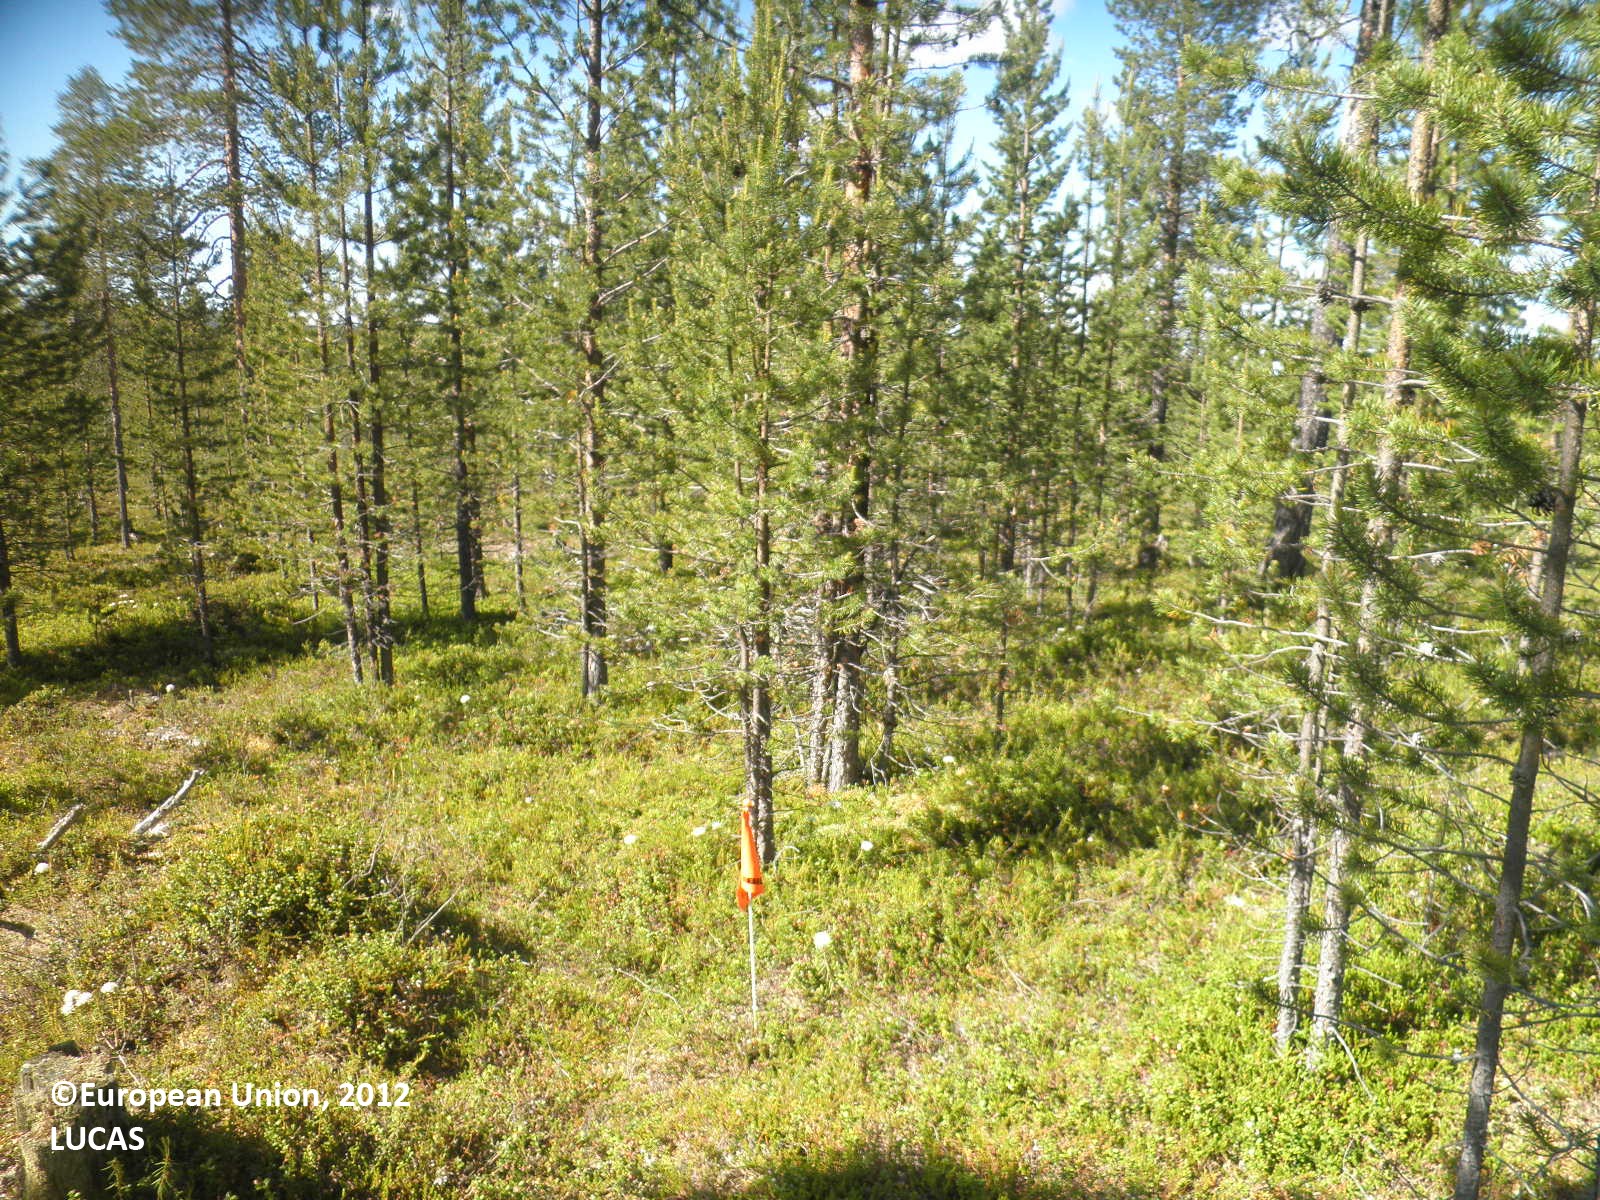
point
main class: Woodland
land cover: Pine dominated coniferous woodland
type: boreal forest
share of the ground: 25 - 50 %
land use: Forestry
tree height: > 5 m
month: July
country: FI
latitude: 68.7972
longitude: 26.8302
